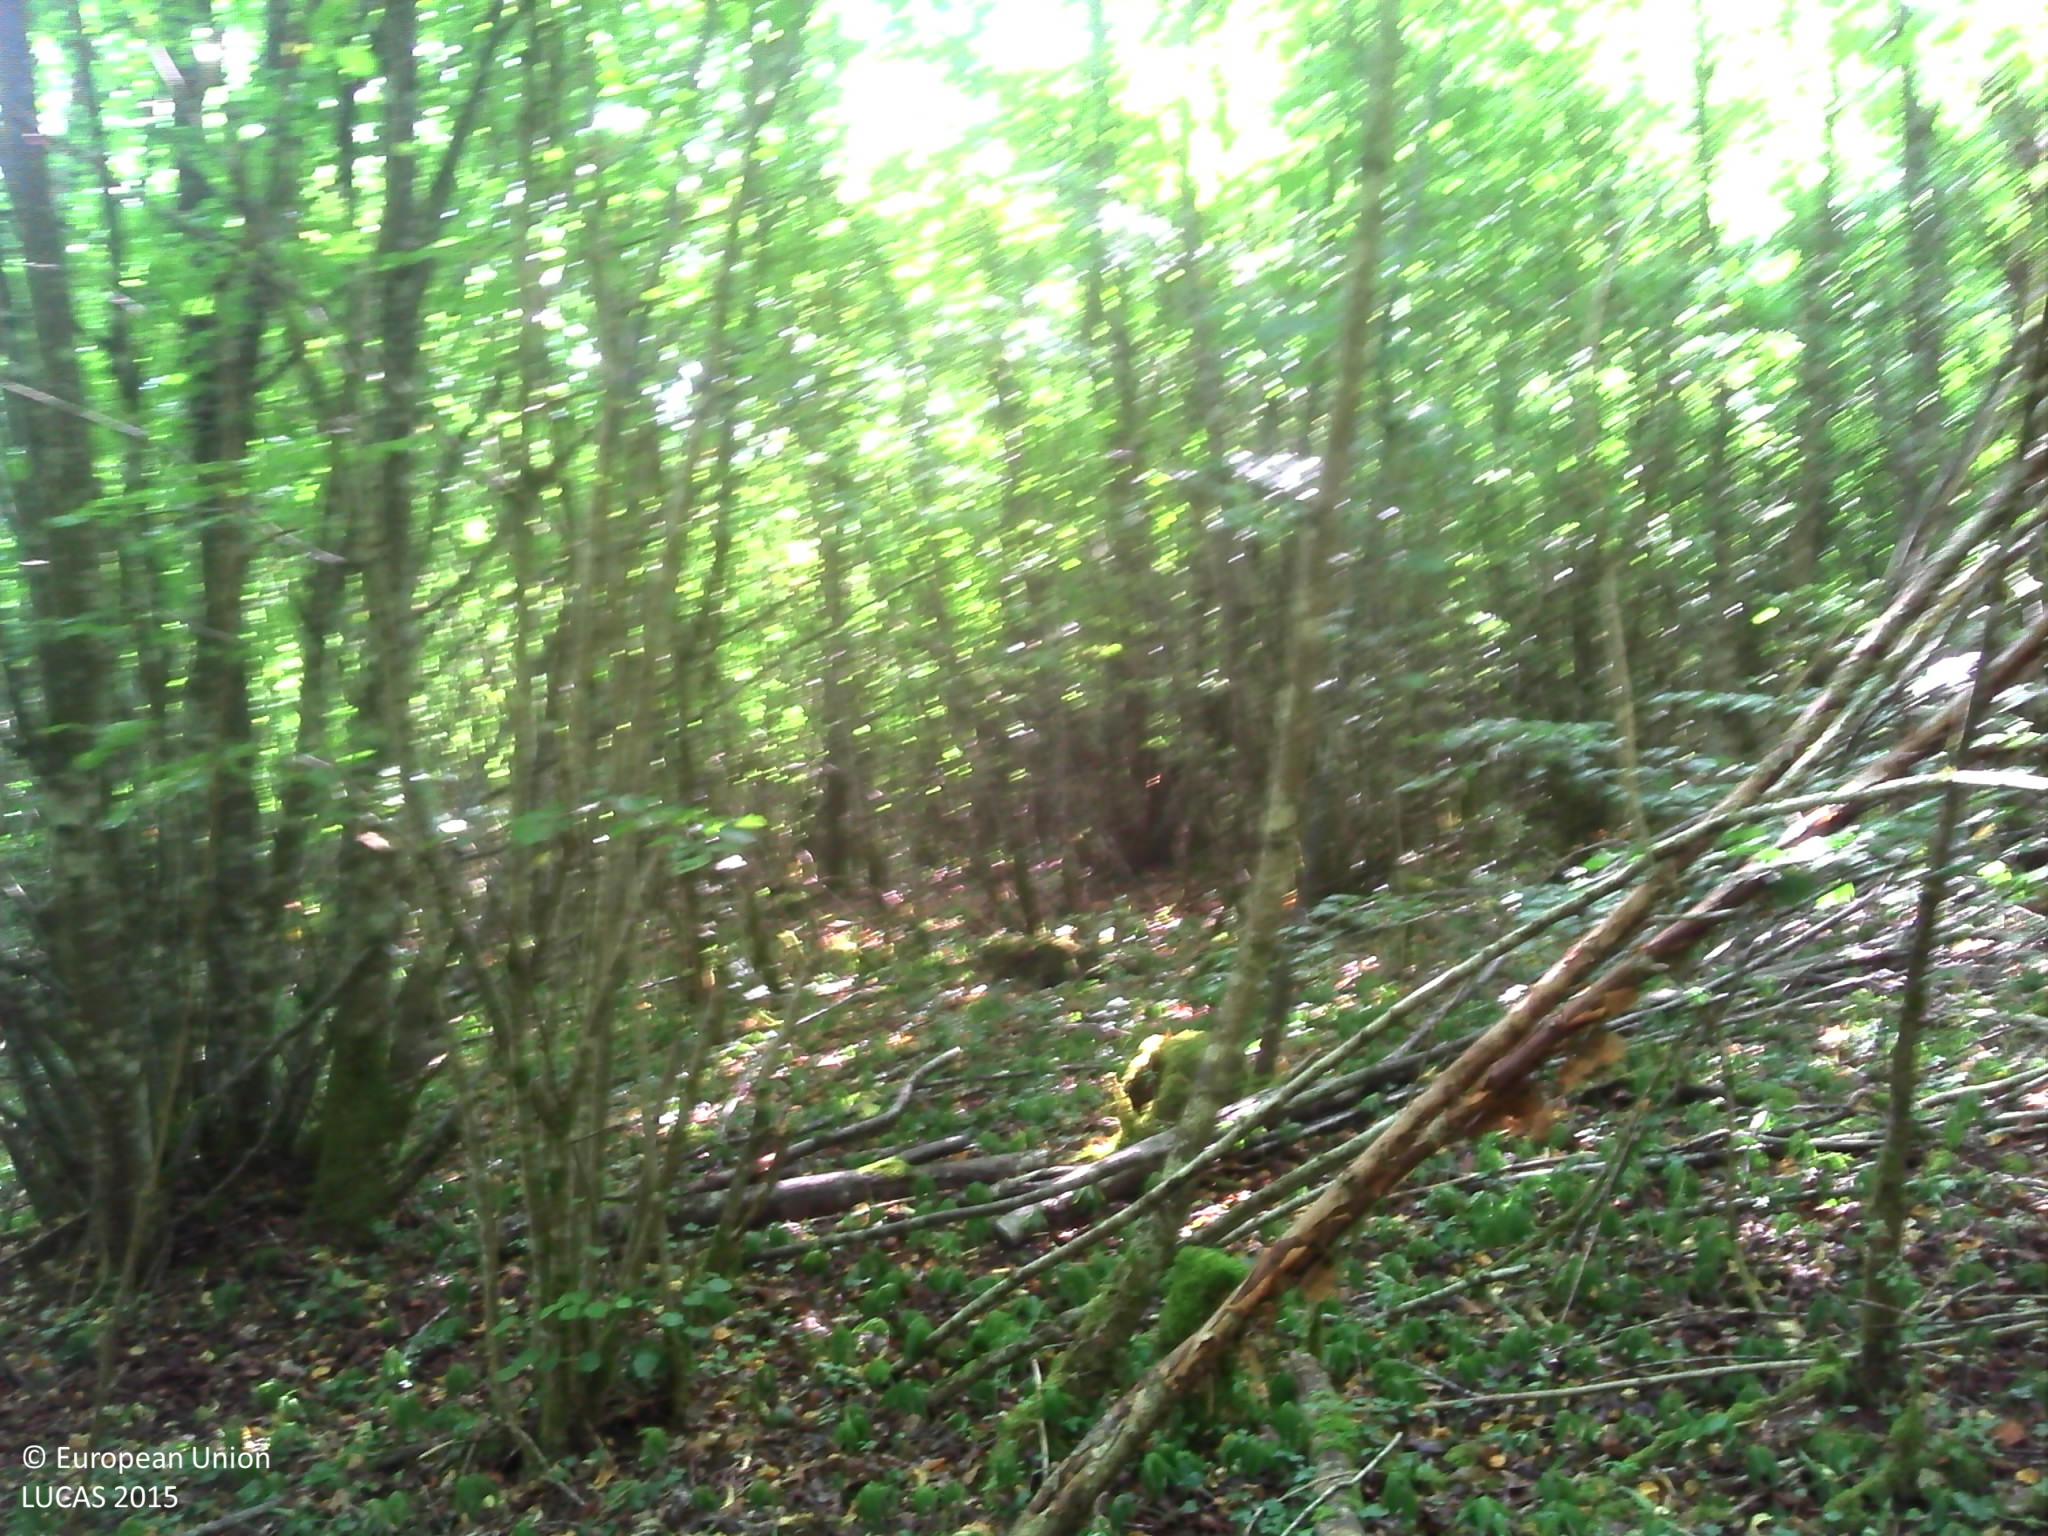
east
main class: Woodland
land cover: Broadleaved woodland
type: beech forest
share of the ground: > 75 %
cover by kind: broadleaved forest trees 85 %, coniferous forest trees 5 %, herbaceous plants 5 %, lichens and mosses 5 %
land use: Forestry
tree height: > 5 m
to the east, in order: Broadleaved woodland; Pine dominated coniferous woodland; Tracks; Broadleaved woodland
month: July
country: FR
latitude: 47.9958
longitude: 4.8661
